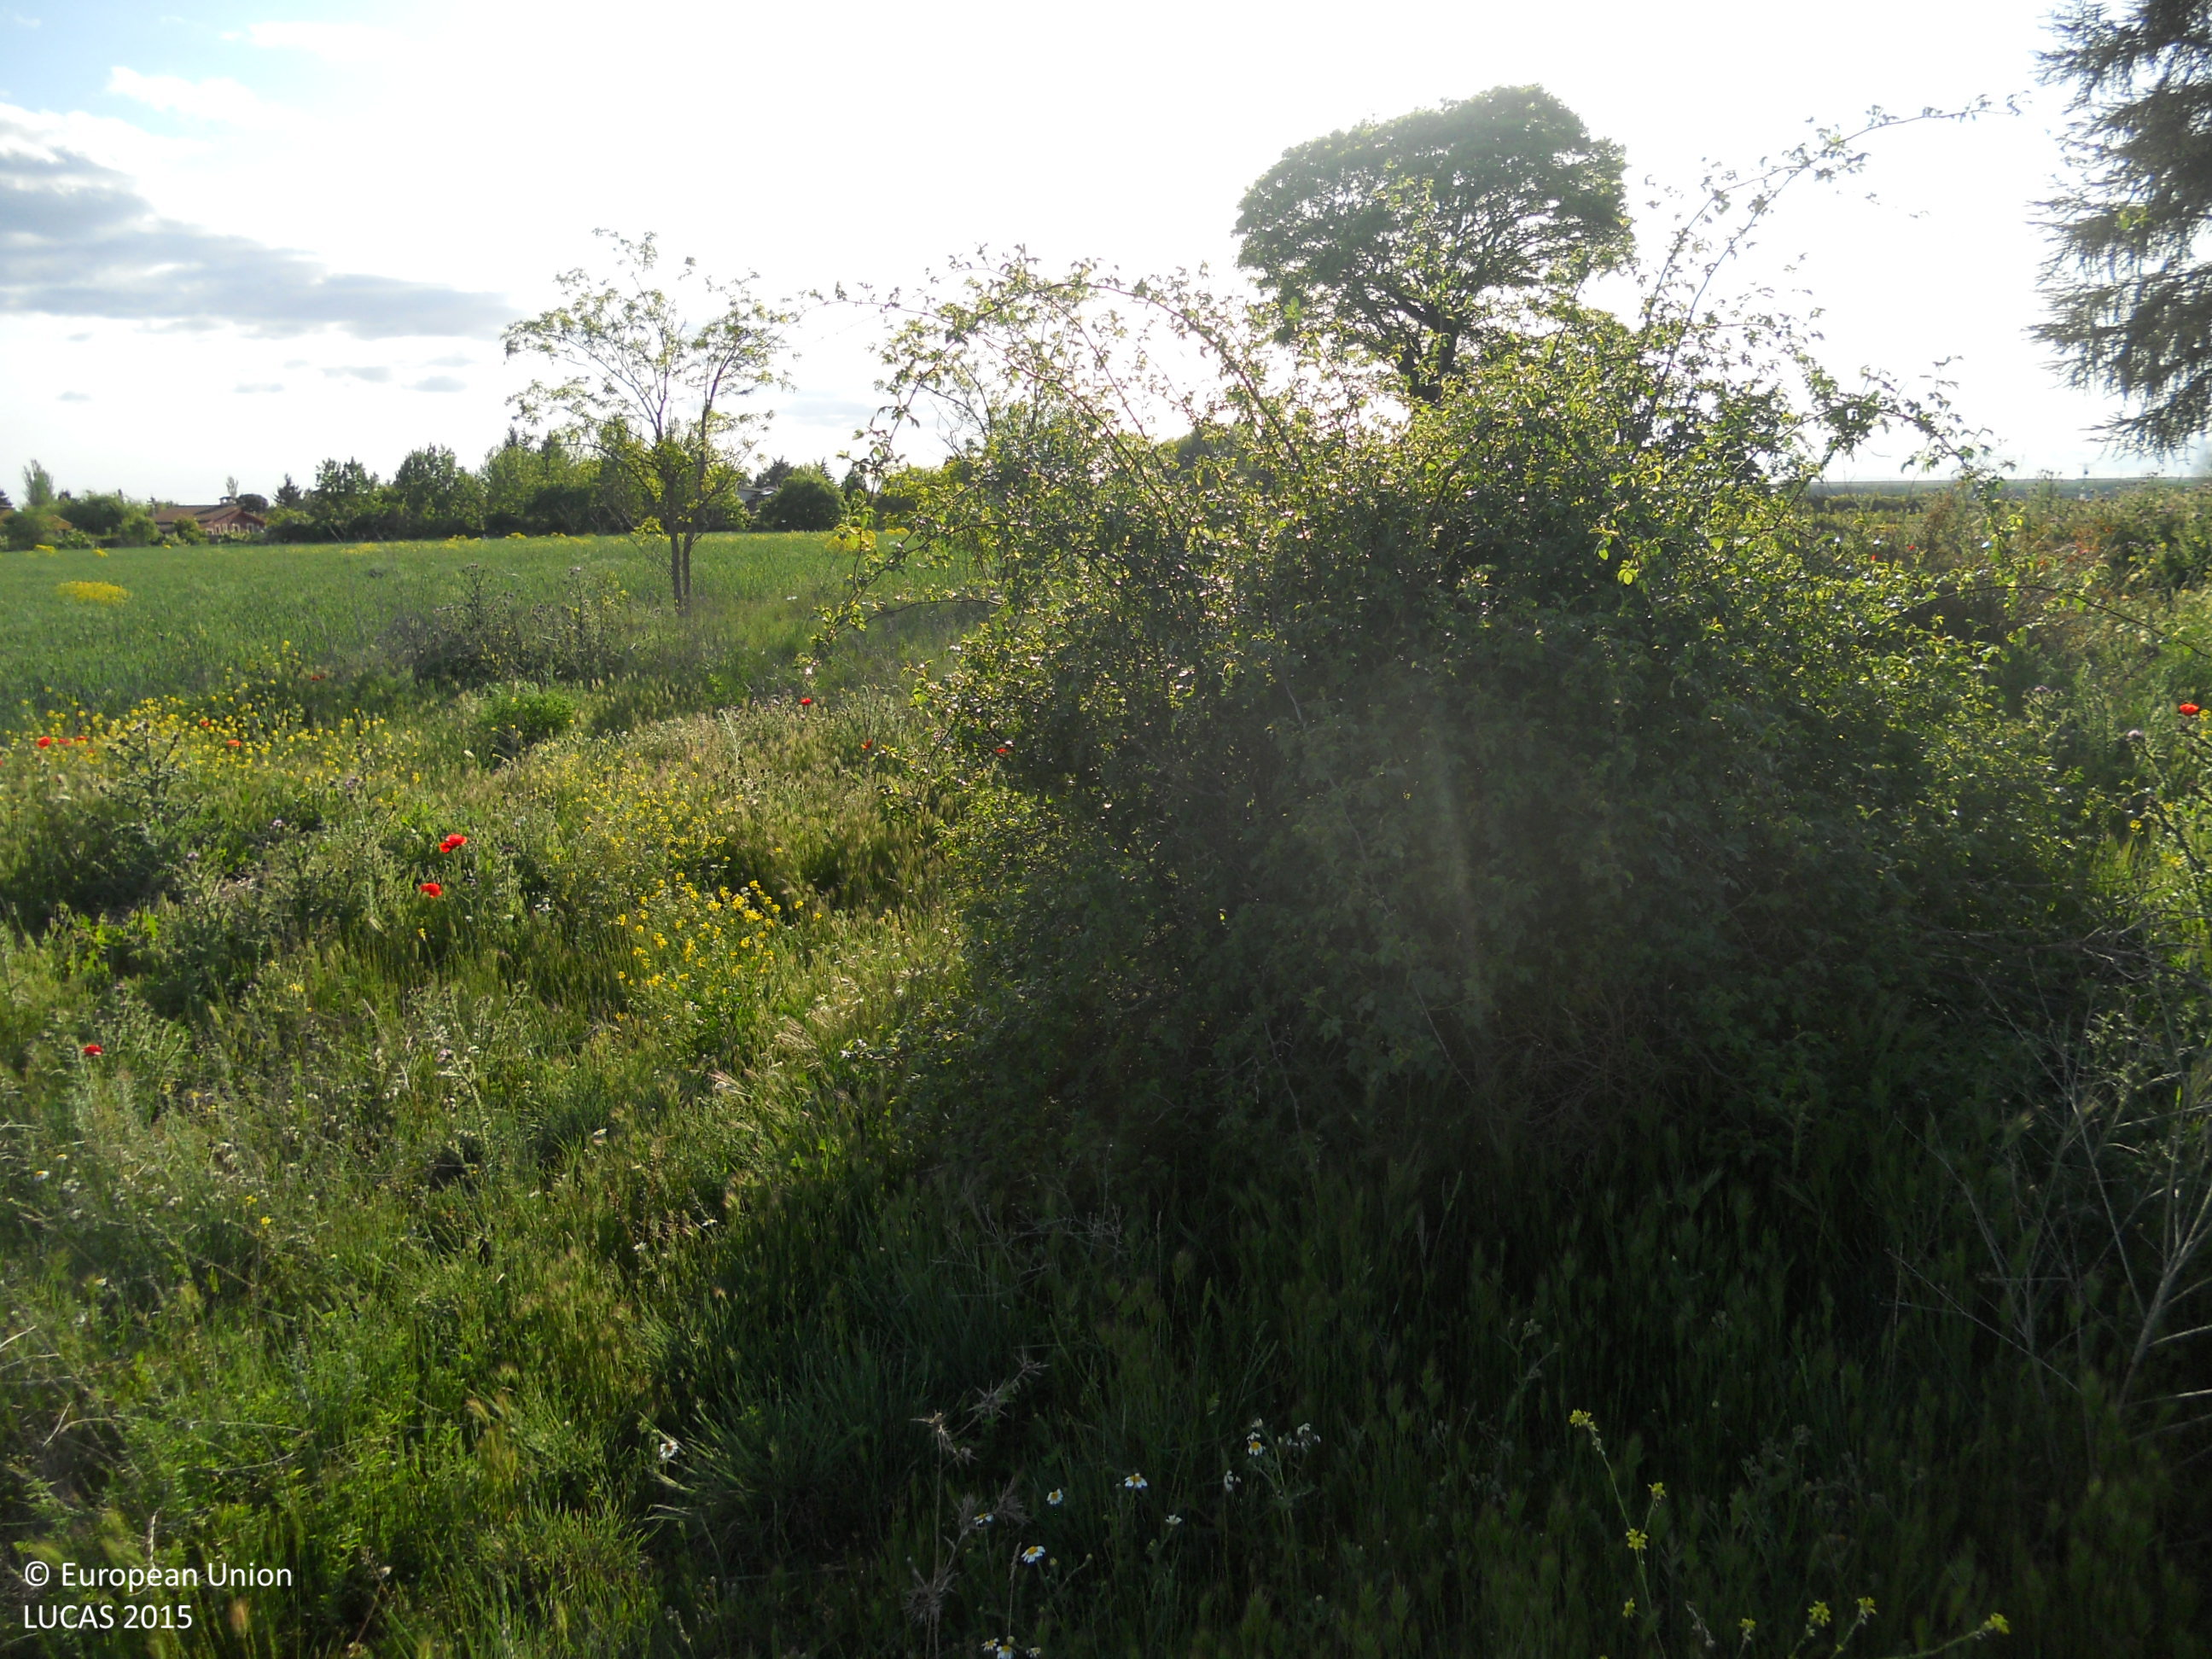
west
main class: Grassland
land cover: Grassland with sparse tree/shrub cover
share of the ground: > 75 %
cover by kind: herbaceous plants 95 %, broadleaved forest trees 5 %
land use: Semi-natural and natural areas not in use
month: May
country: ES
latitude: 42.3131
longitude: -5.5127
